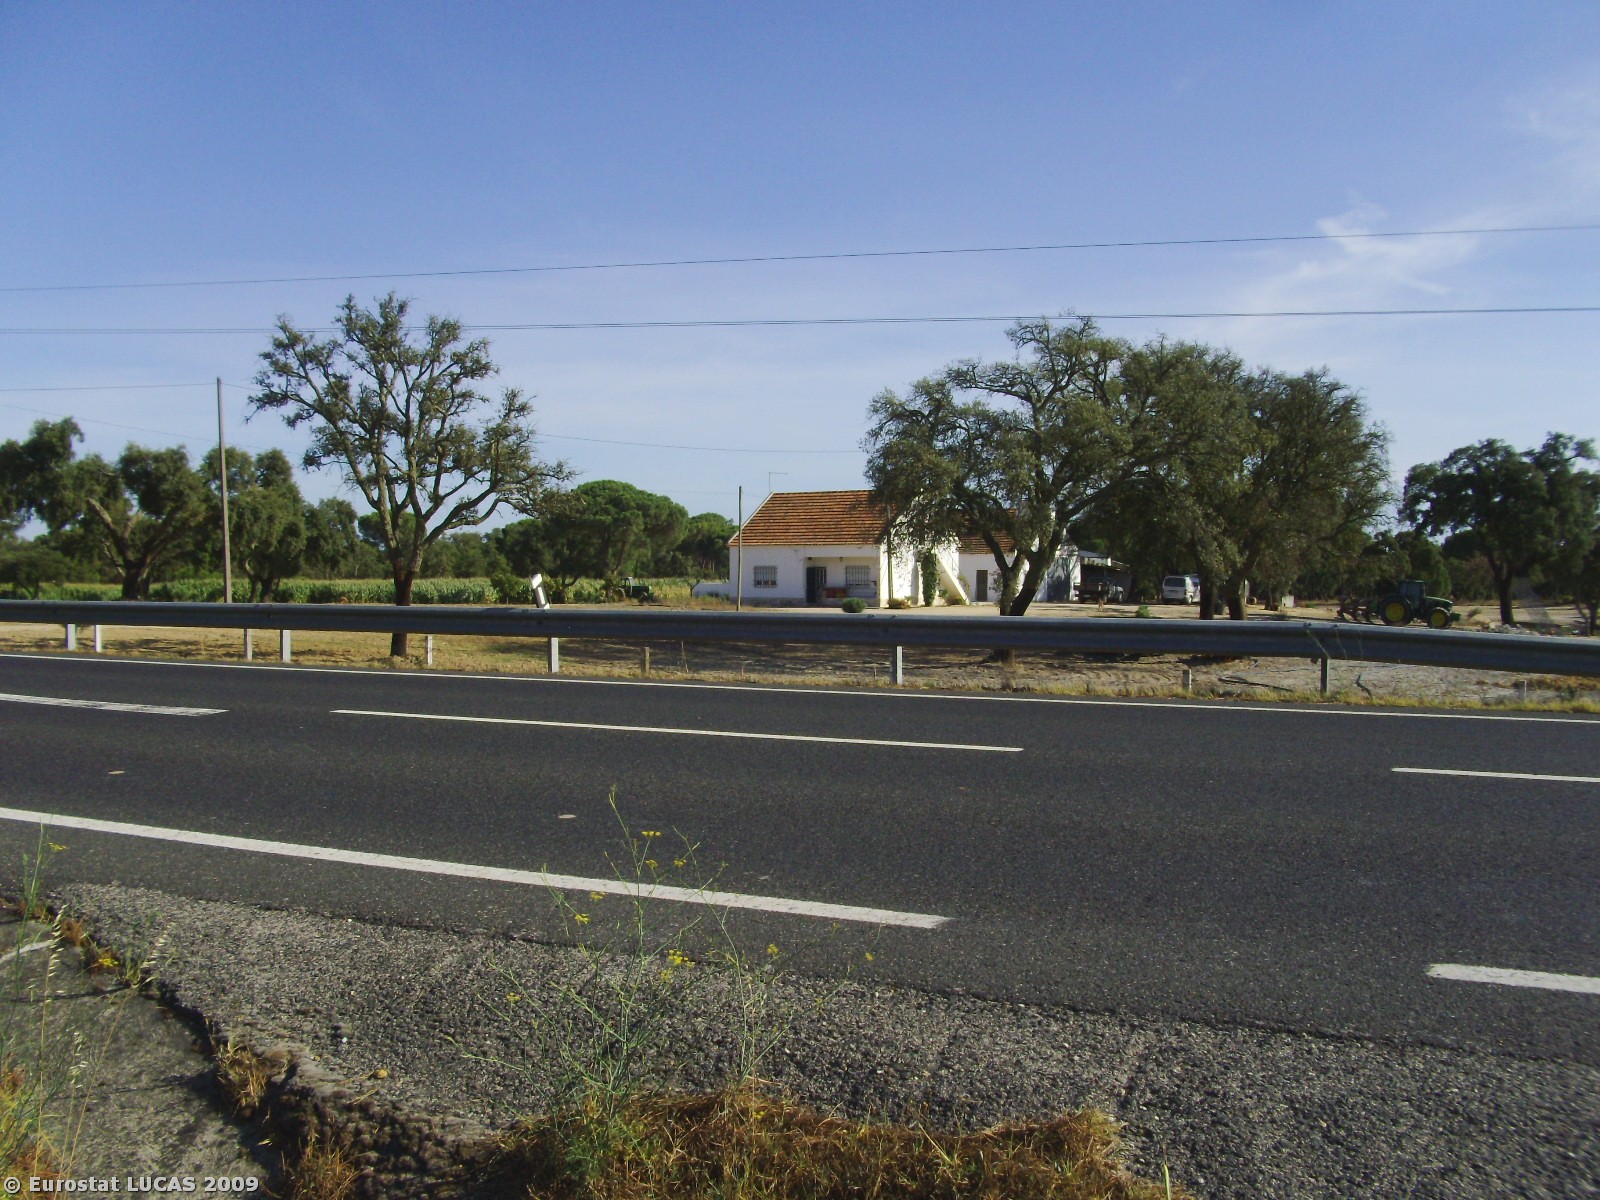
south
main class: Grassland
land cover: Spontaneously vegetated surfaces
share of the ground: > 75 %
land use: Fallow land
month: August
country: PT
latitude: 38.7228
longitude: -8.6368
